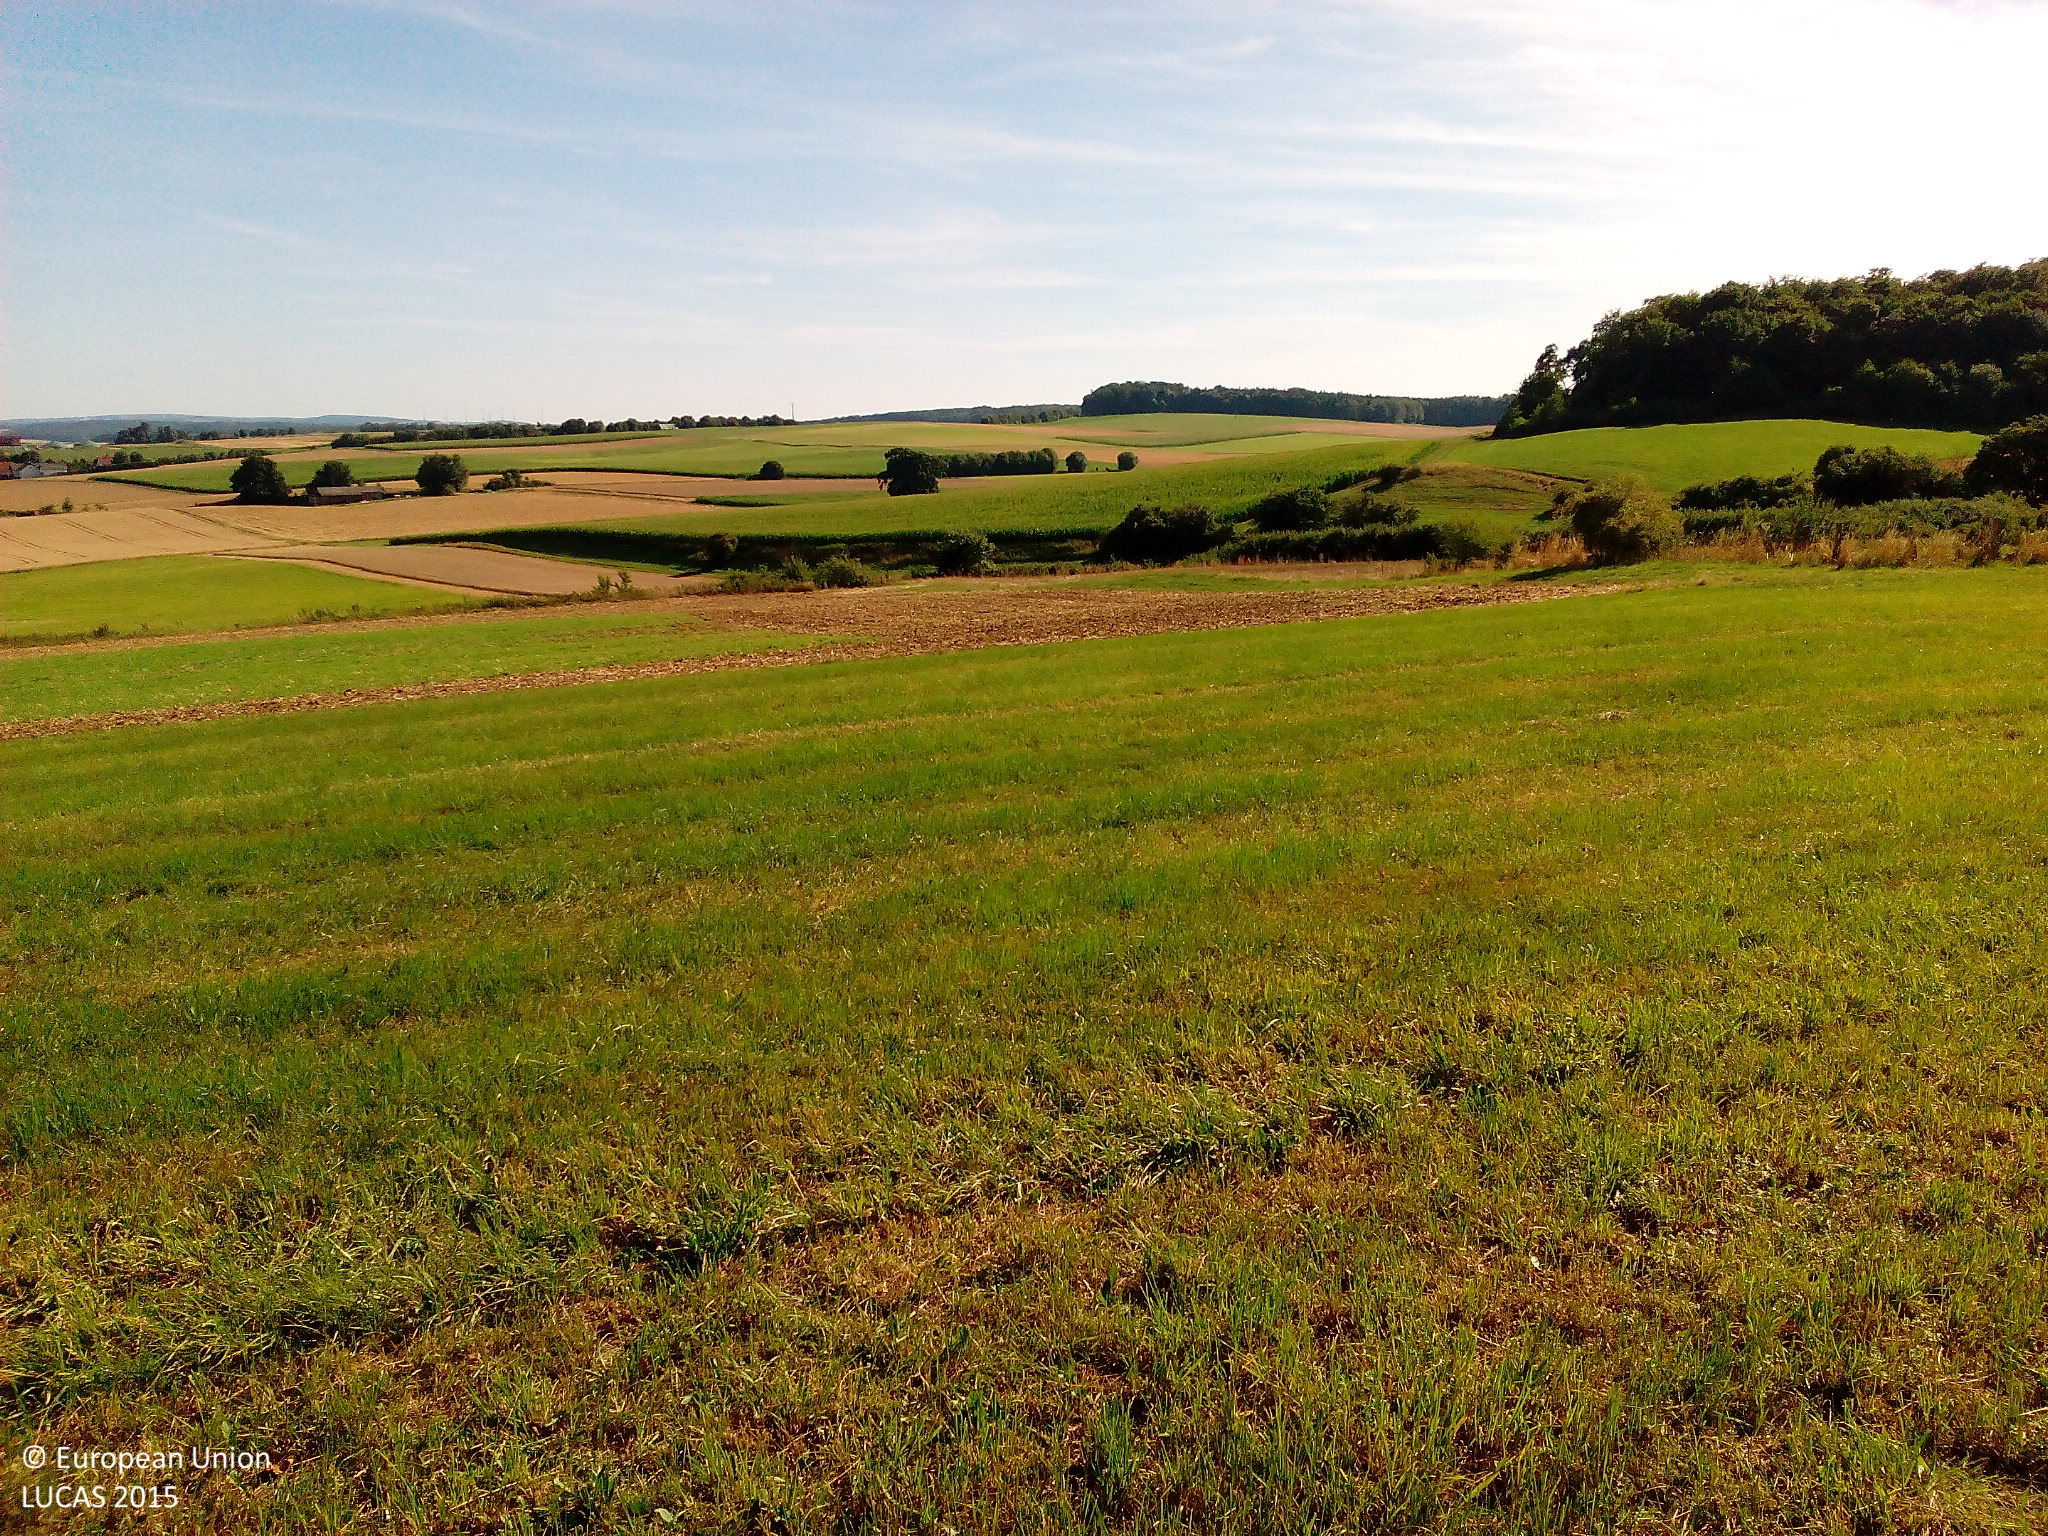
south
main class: Grassland
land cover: Grassland without tree/shrub cover
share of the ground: > 75 %
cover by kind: herbaceous plants 100 %
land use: Agriculture (excluding fallow land and kitchen gardens)
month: August
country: DE
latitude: 50.7568
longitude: 9.1922
